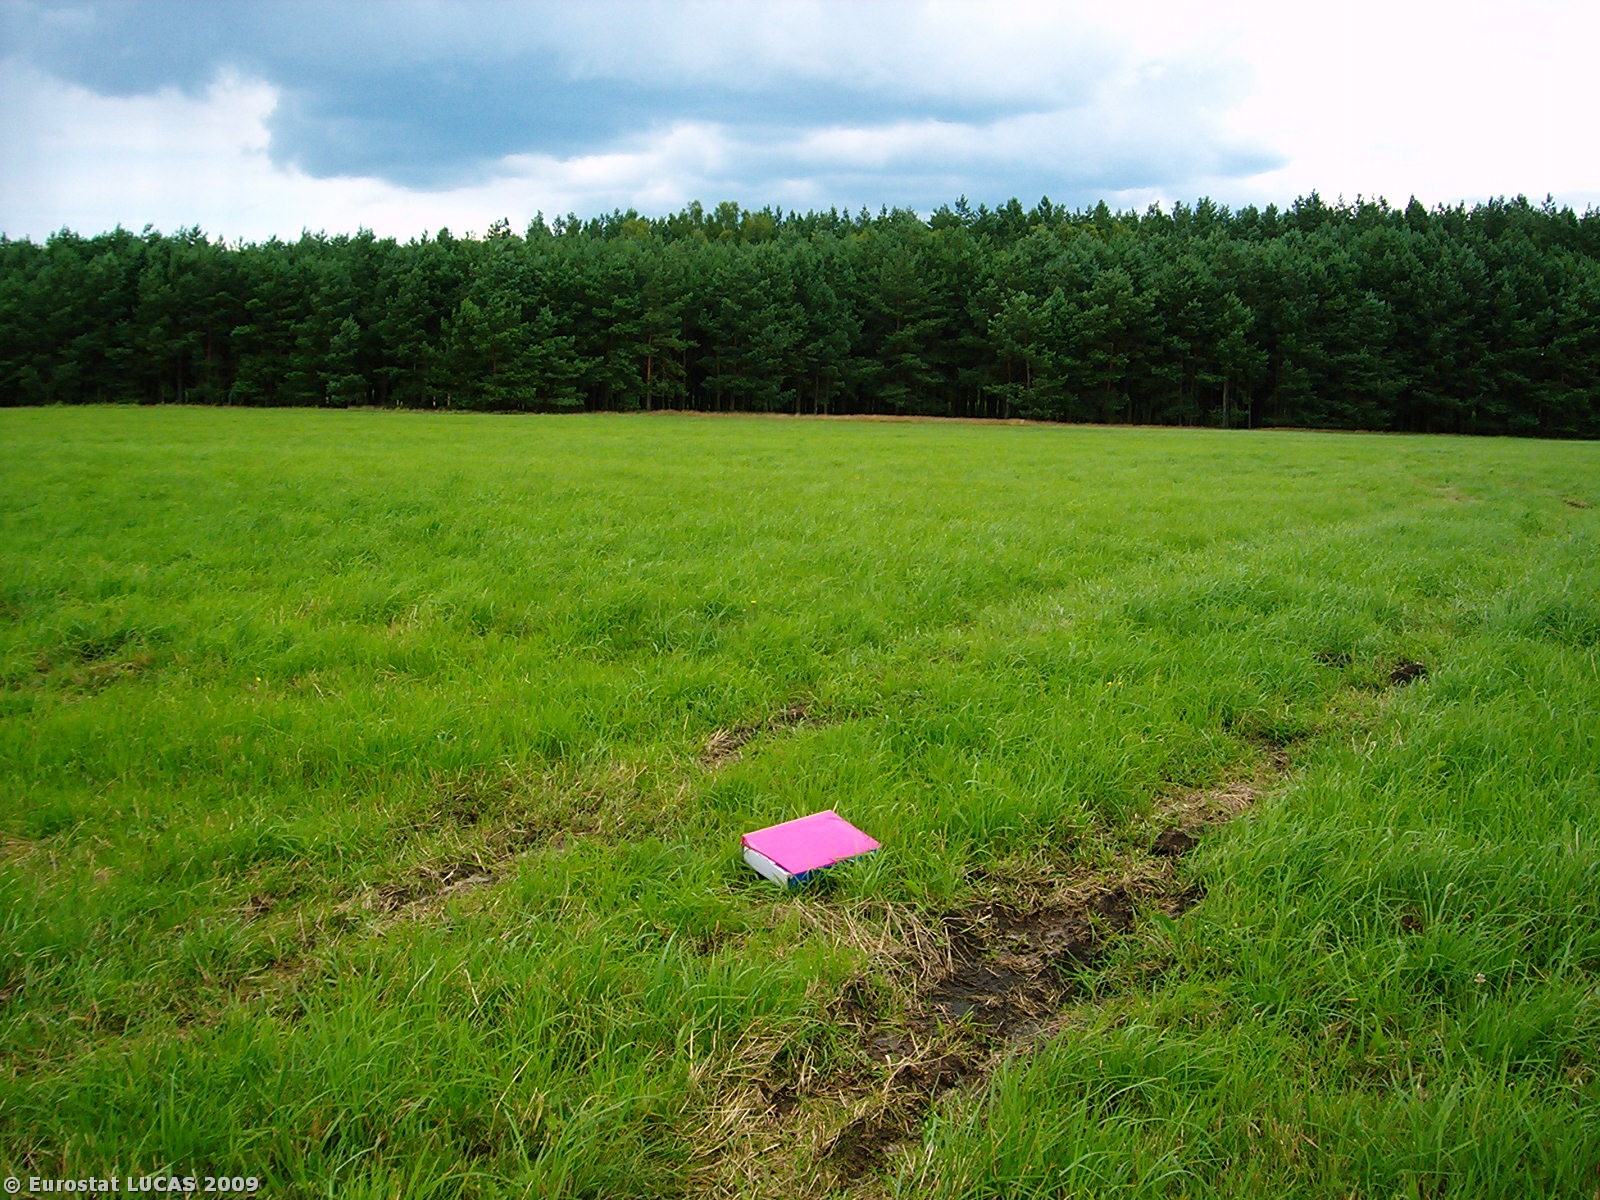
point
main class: Grassland
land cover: Grassland without tree/shrub cover
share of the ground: > 75 %
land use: Agriculture (excluding fallow land and kitchen gardens)
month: July
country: PL
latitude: 52.2942
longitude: 15.7083
